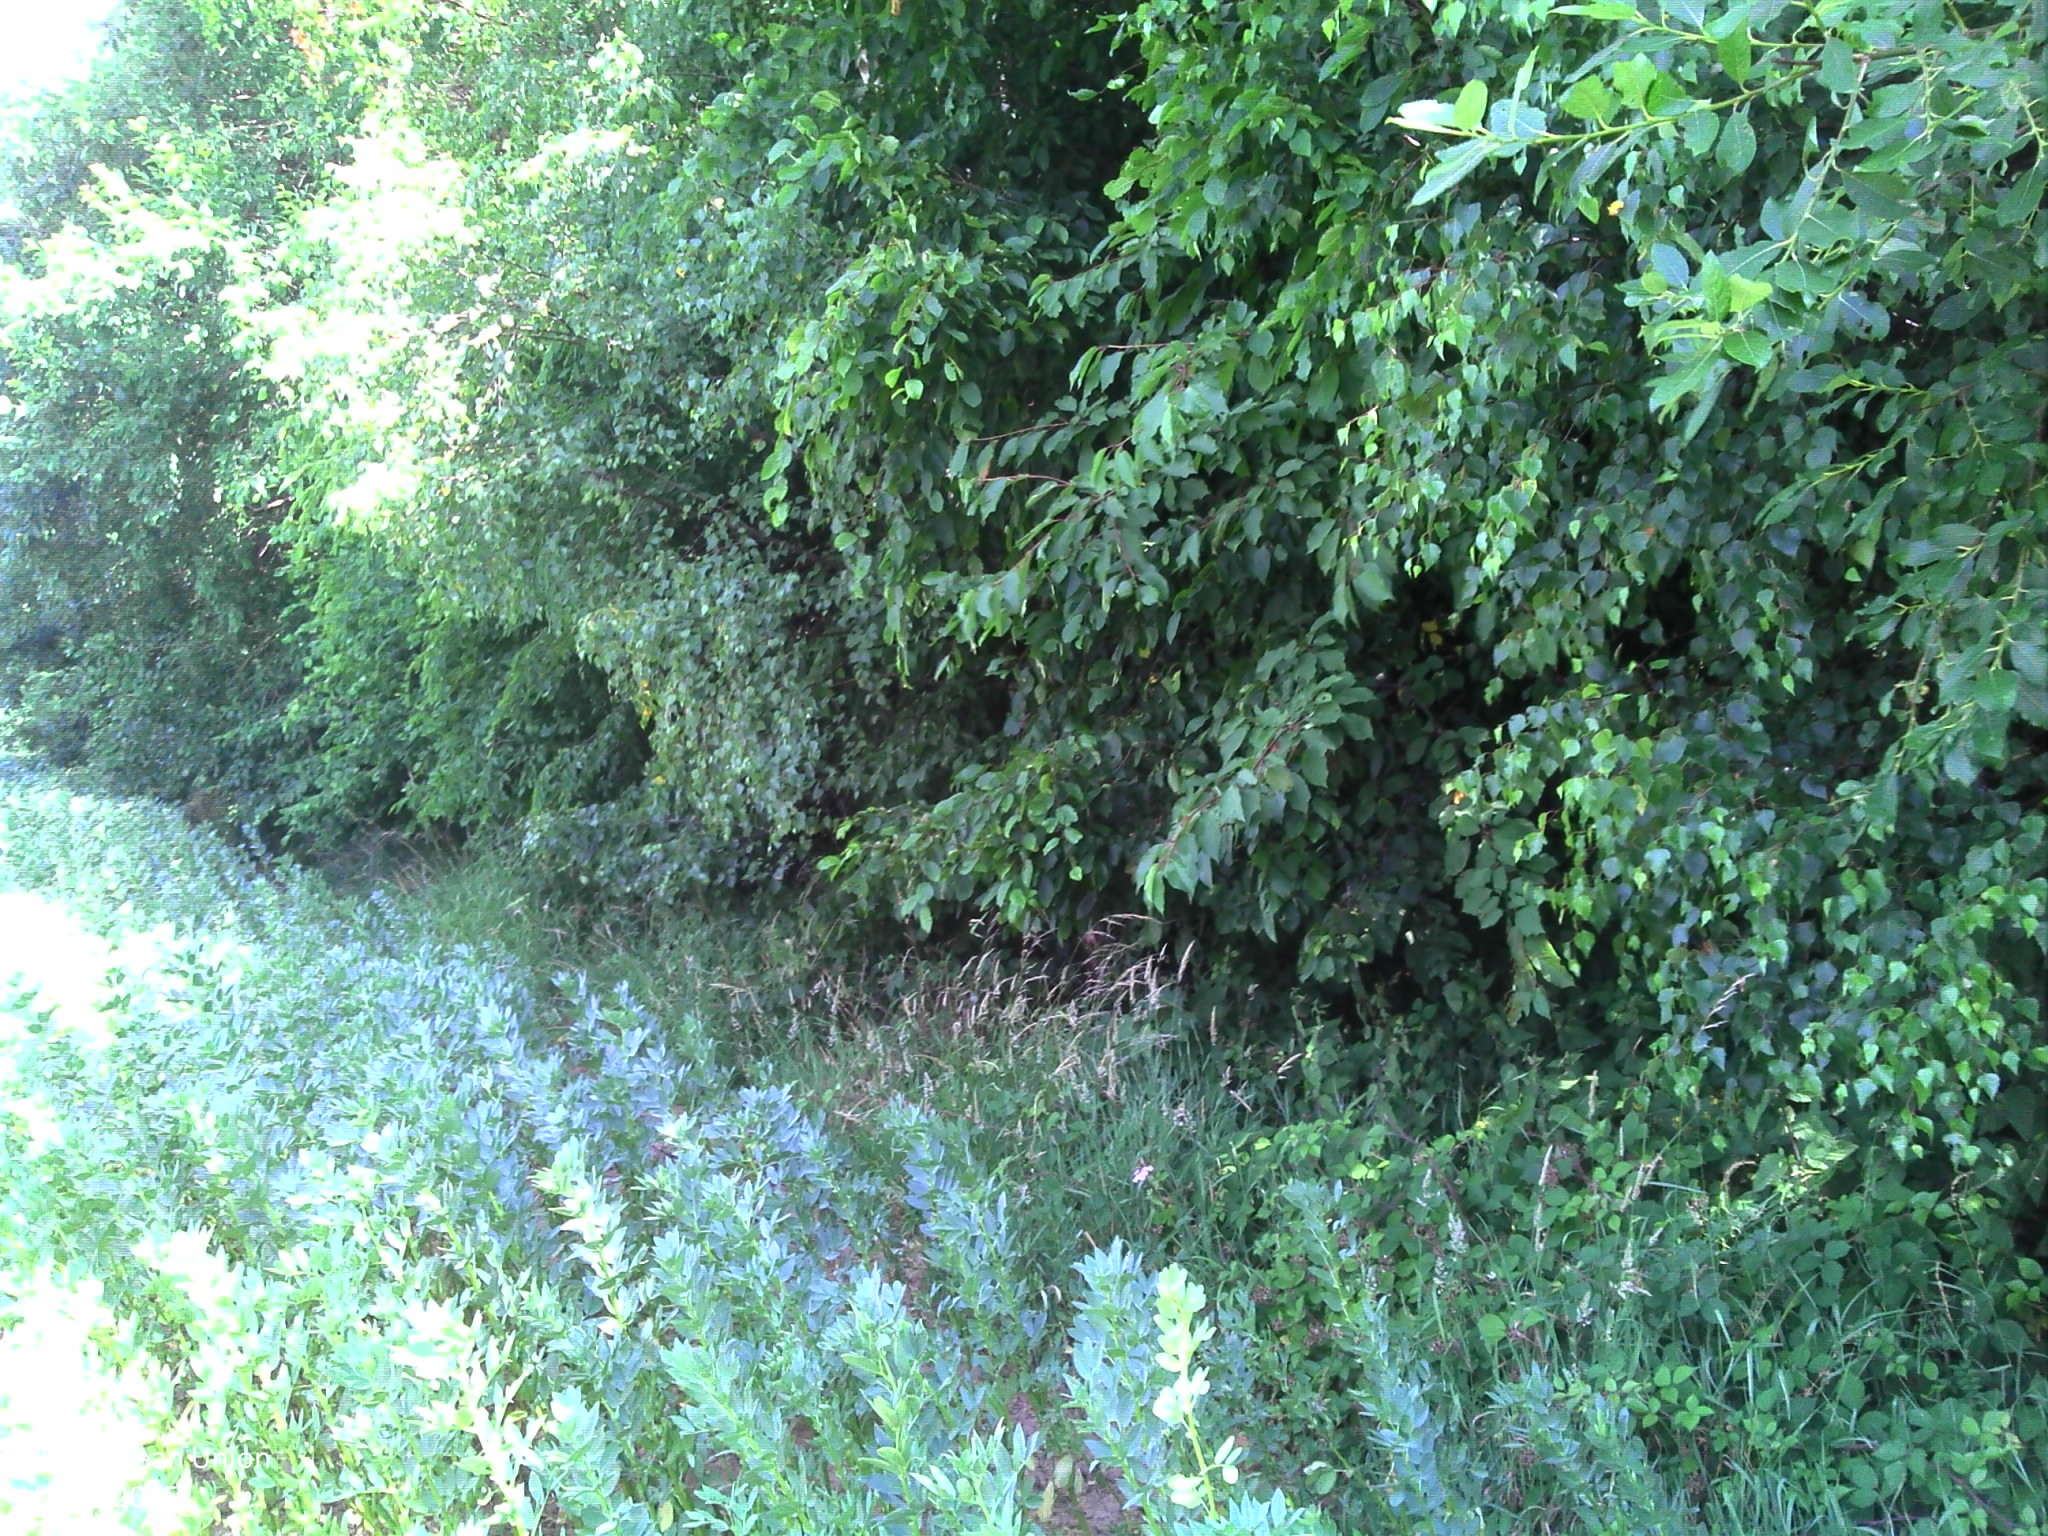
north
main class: Cropland
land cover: Dry pulses
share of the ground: > 75 %
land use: Agriculture (excluding fallow land and kitchen gardens)
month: July
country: FR
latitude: 49.4623
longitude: 5.9014
